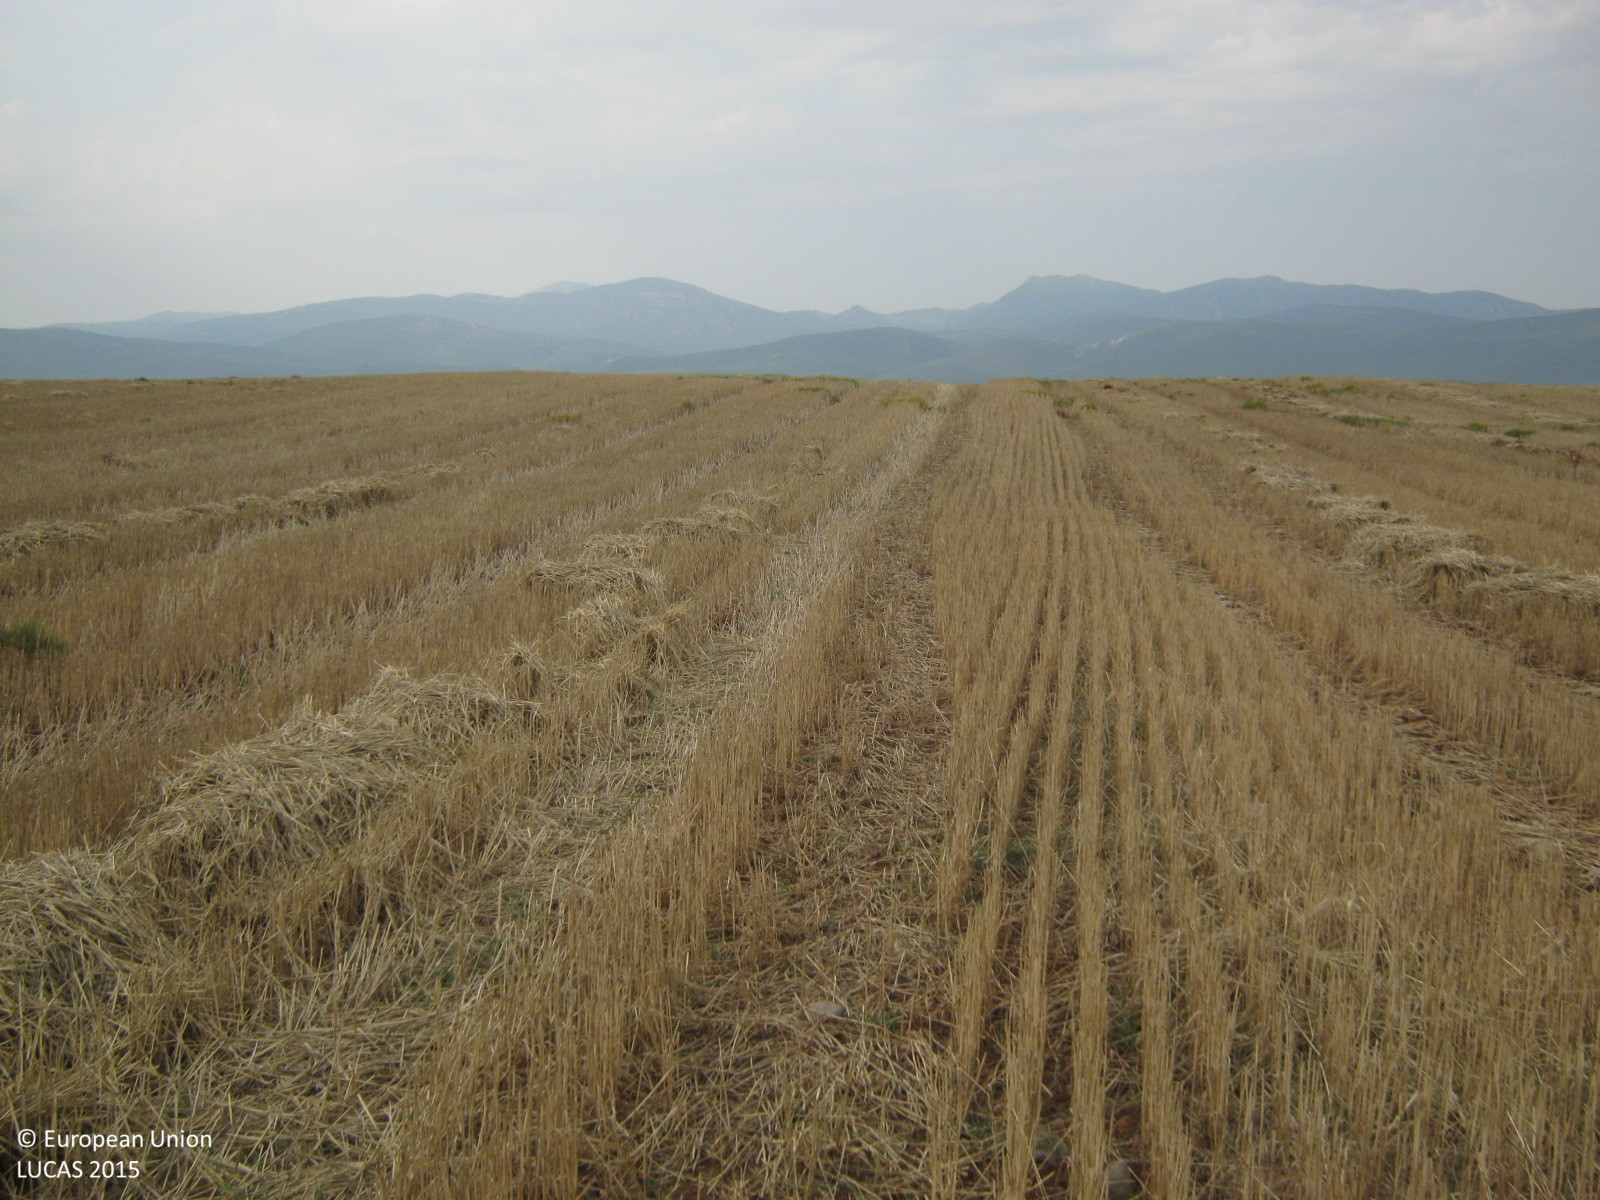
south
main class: Cropland
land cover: Durum wheat
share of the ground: < 10 %
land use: Agriculture (excluding fallow land and kitchen gardens)
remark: Harvested field
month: July
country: GR
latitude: 39.2019
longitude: 22.6898
